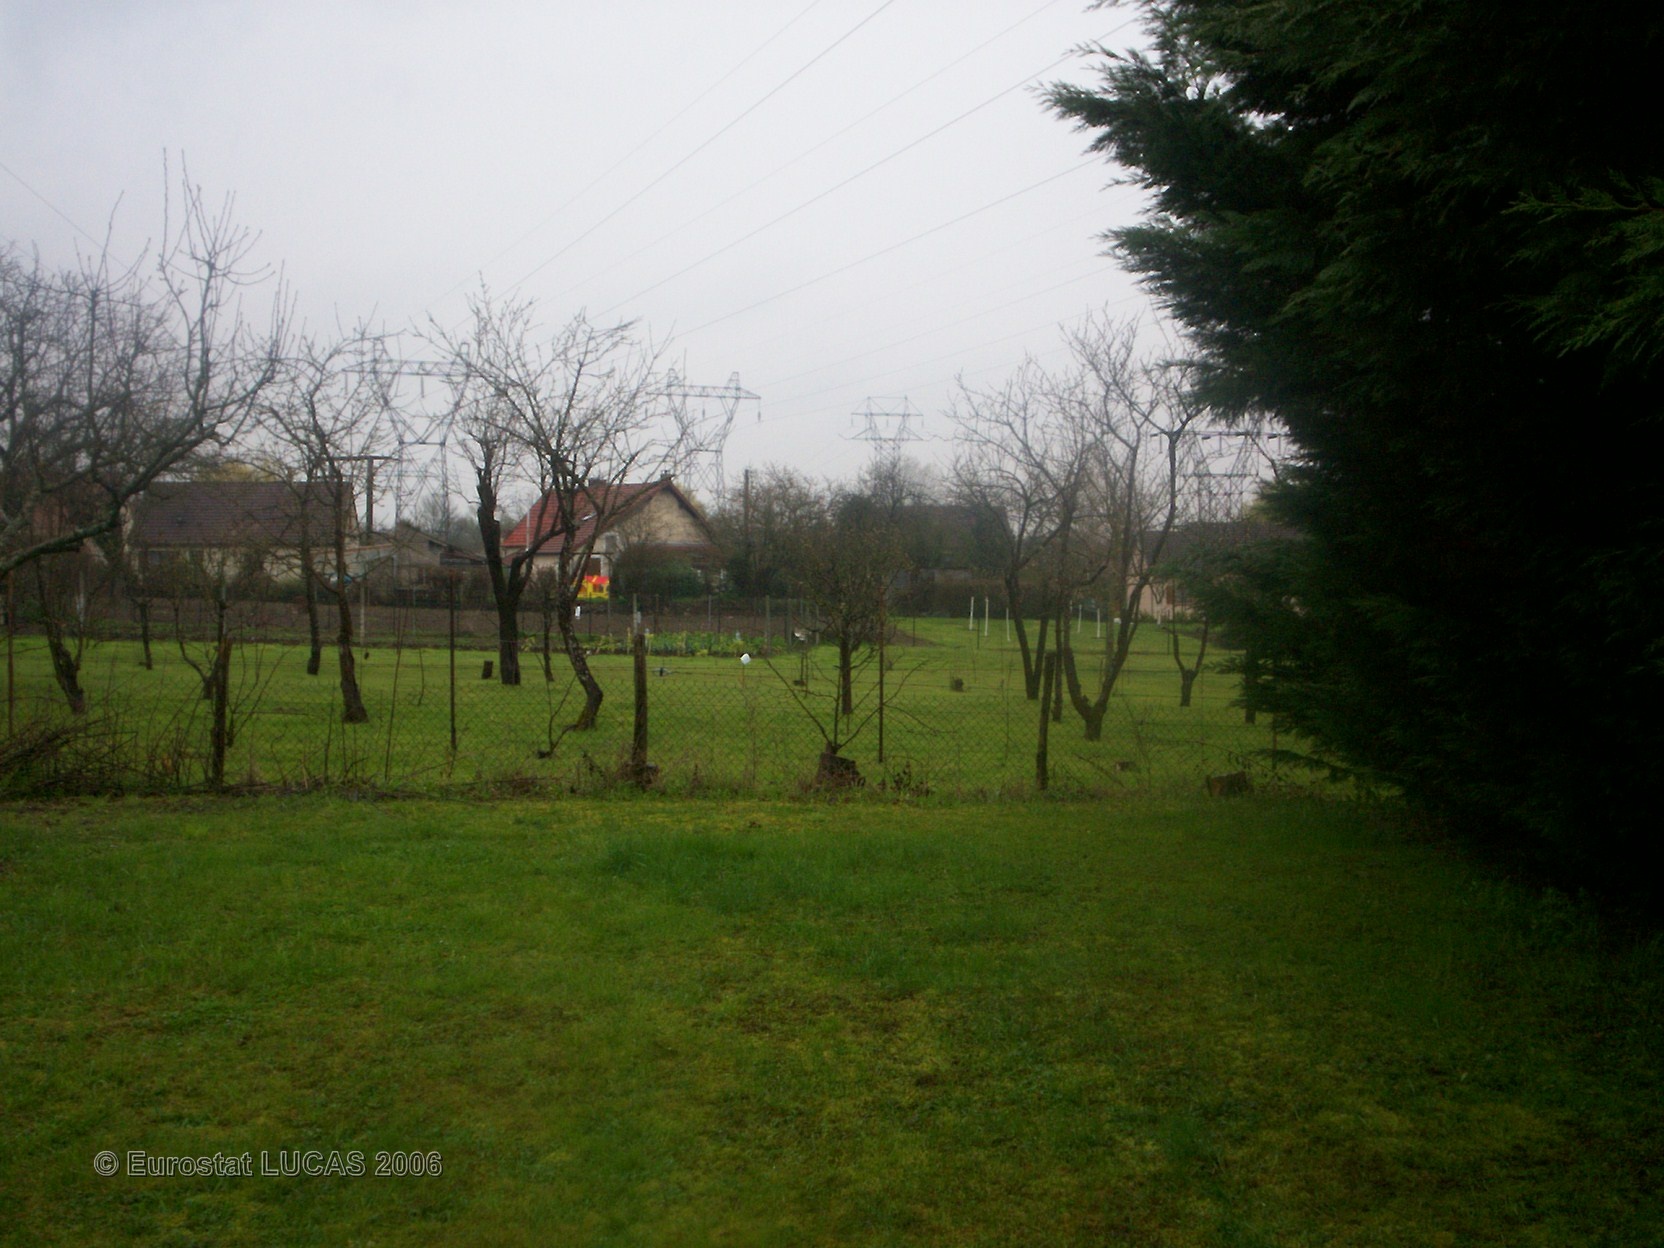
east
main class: Grassland
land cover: Grassland with sparse tree/shrub cover
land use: Residential
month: April
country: FR
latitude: 47.0311
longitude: 3.0876
